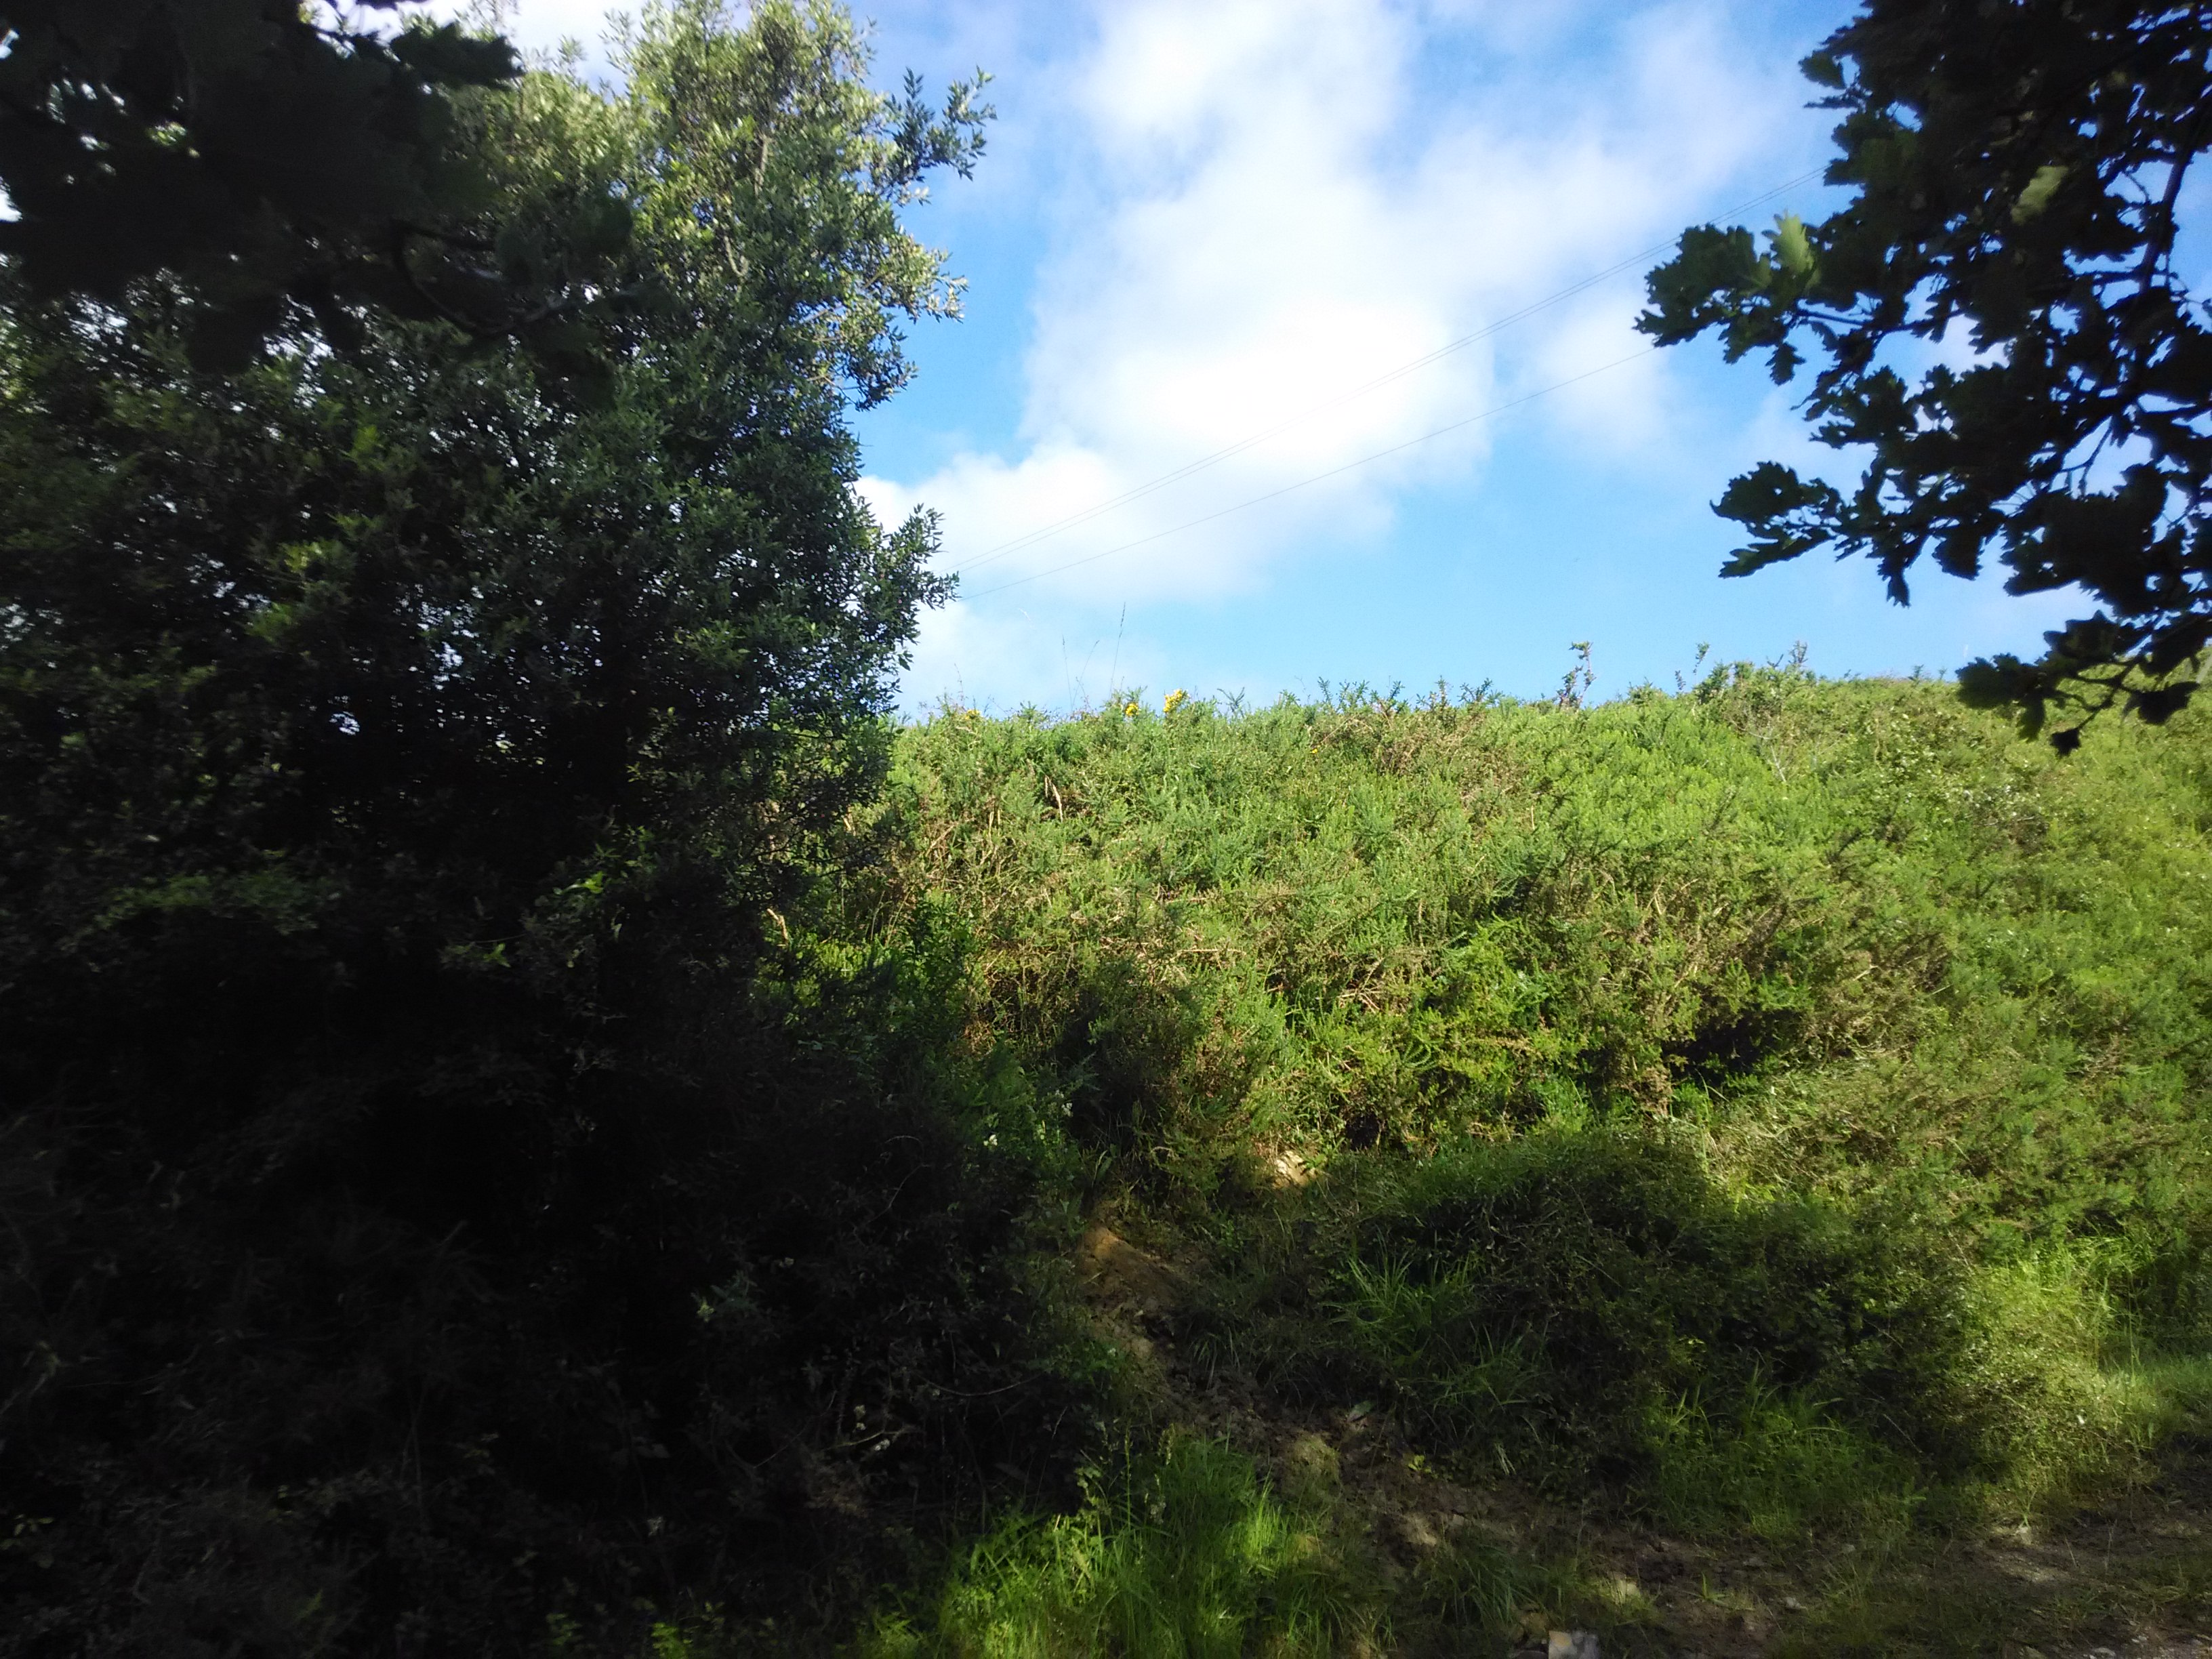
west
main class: Woodland
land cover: Broadleaved woodland
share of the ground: 25 - 50 %
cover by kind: broadleaved forest trees 40 %, shrubs 40 %, consolidated bare surface 20 %
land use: Forestry
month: June
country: ES
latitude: 43.2741
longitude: -2.2608
